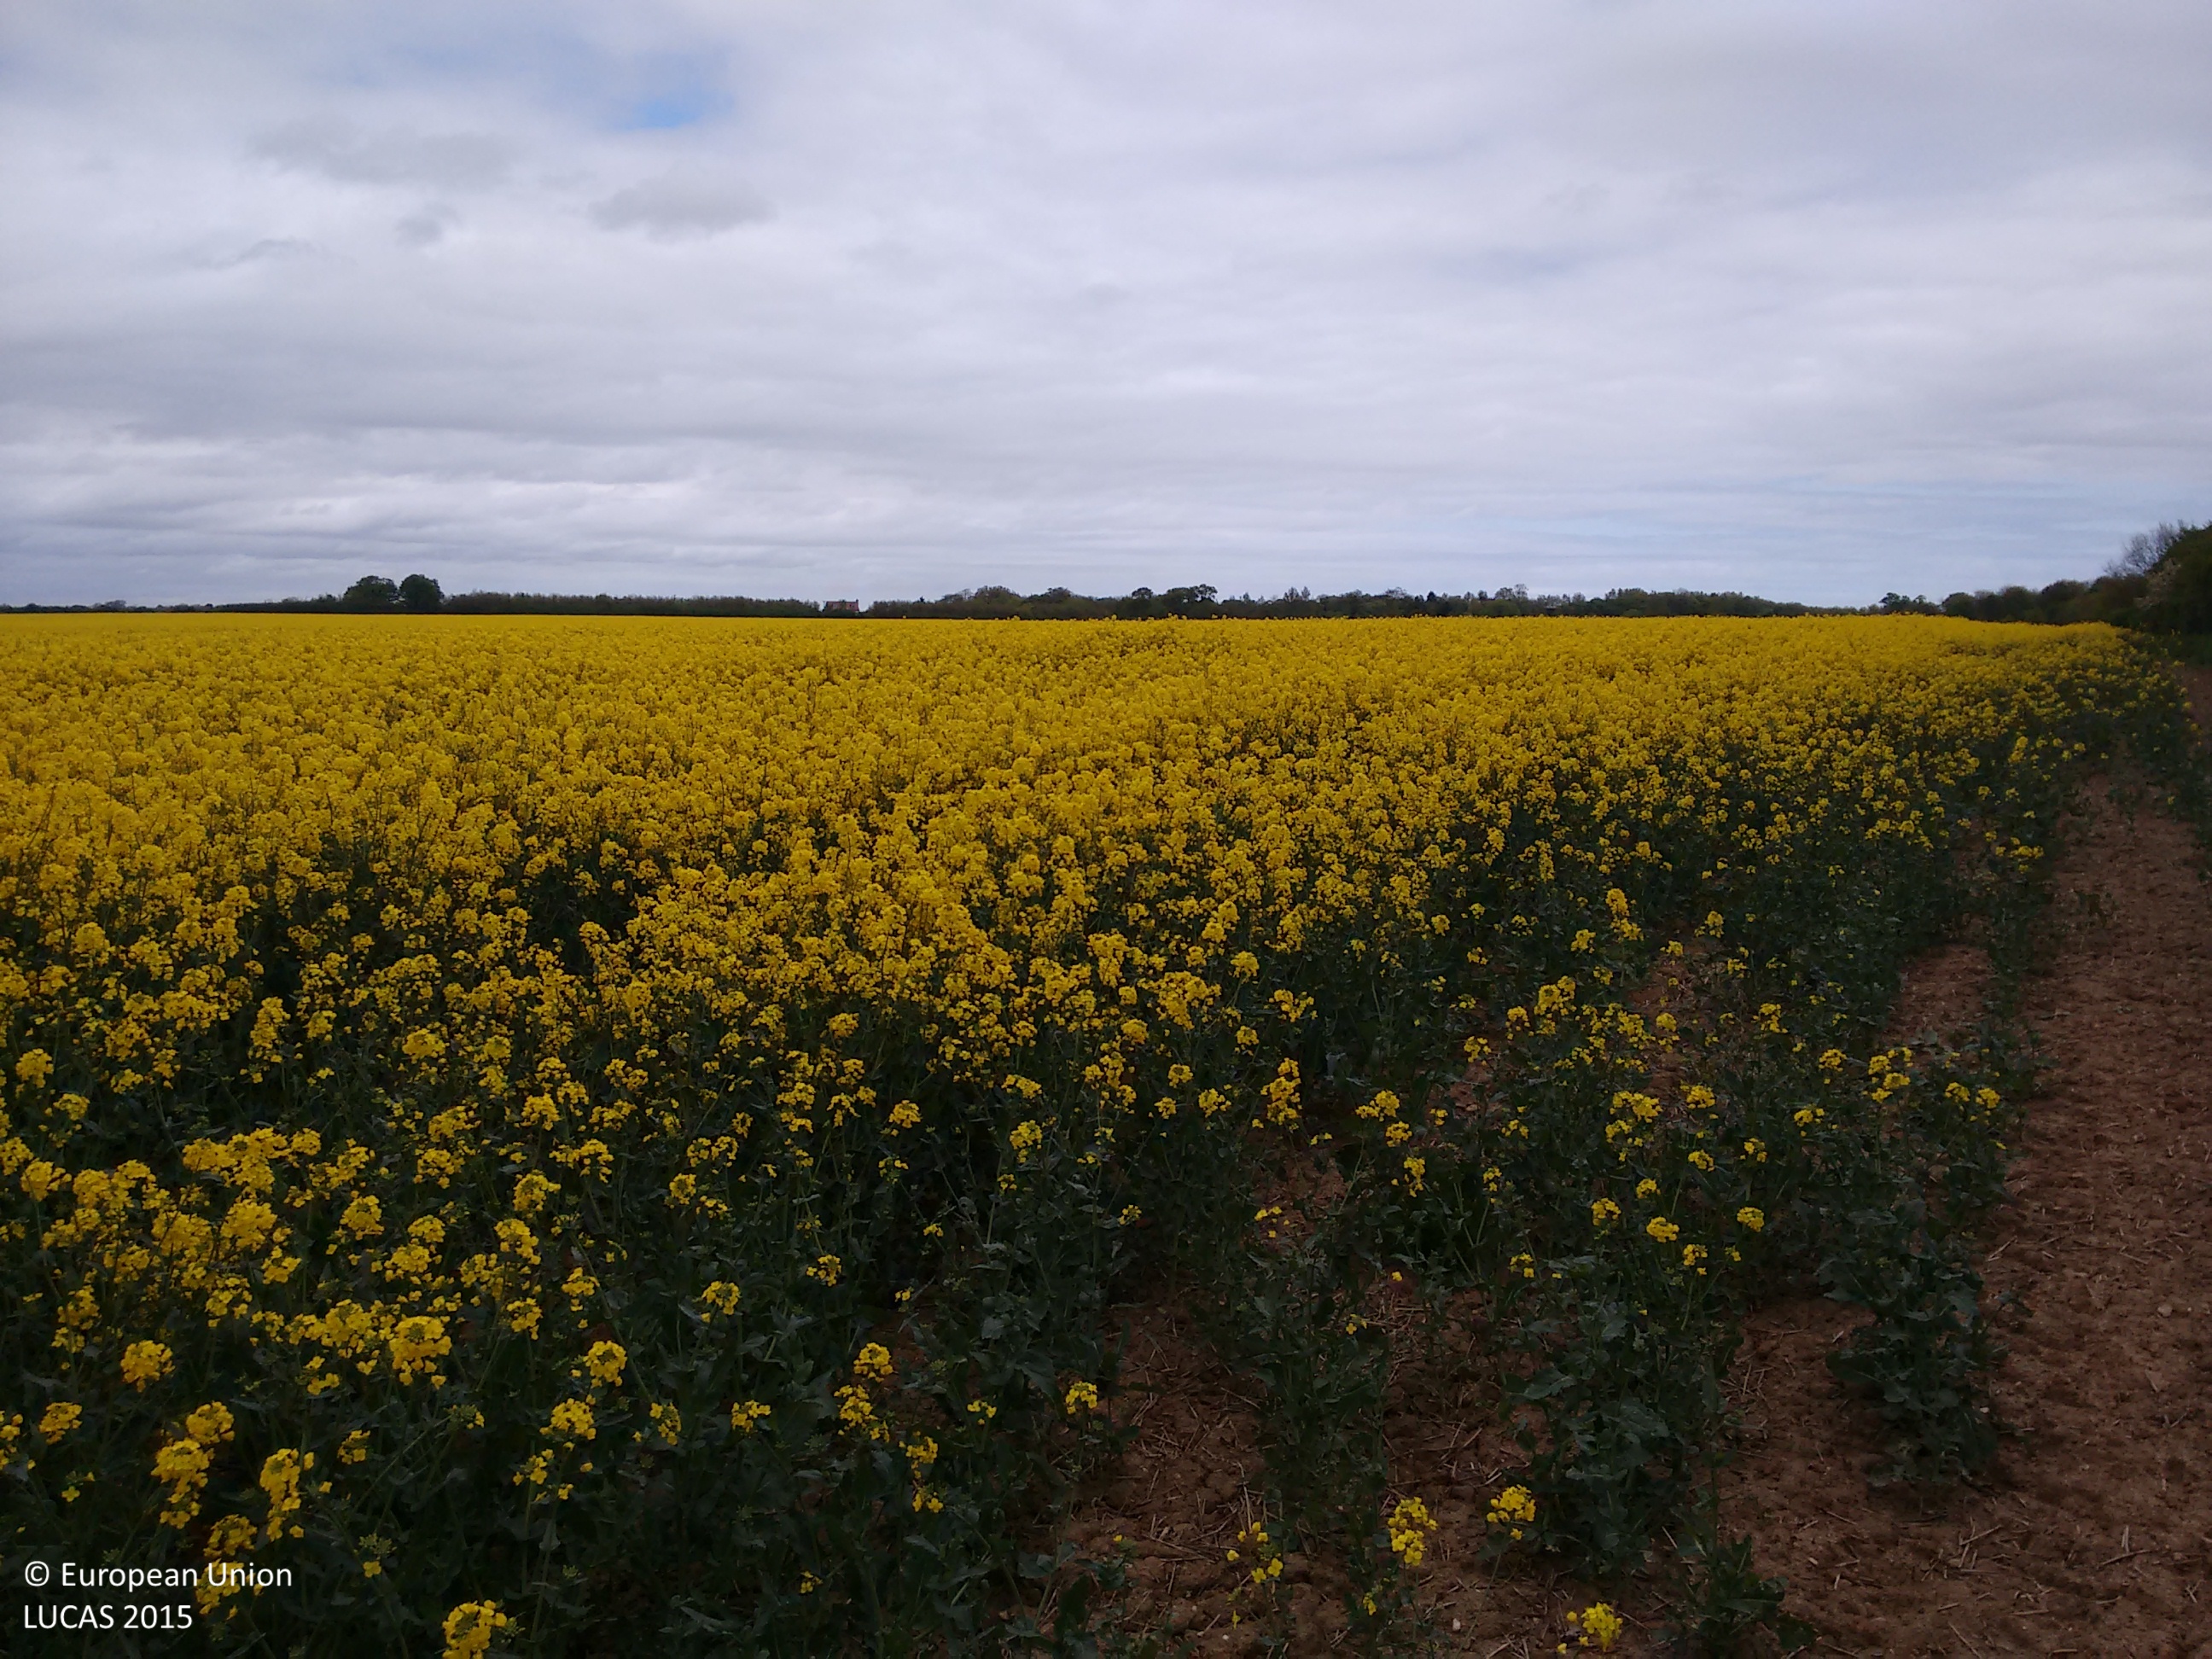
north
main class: Cropland
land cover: Rape and turnip rape
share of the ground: > 75 %
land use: Agriculture (excluding fallow land and kitchen gardens)
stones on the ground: < 10 %
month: May
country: GB
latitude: 53.8173
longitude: -0.2564
